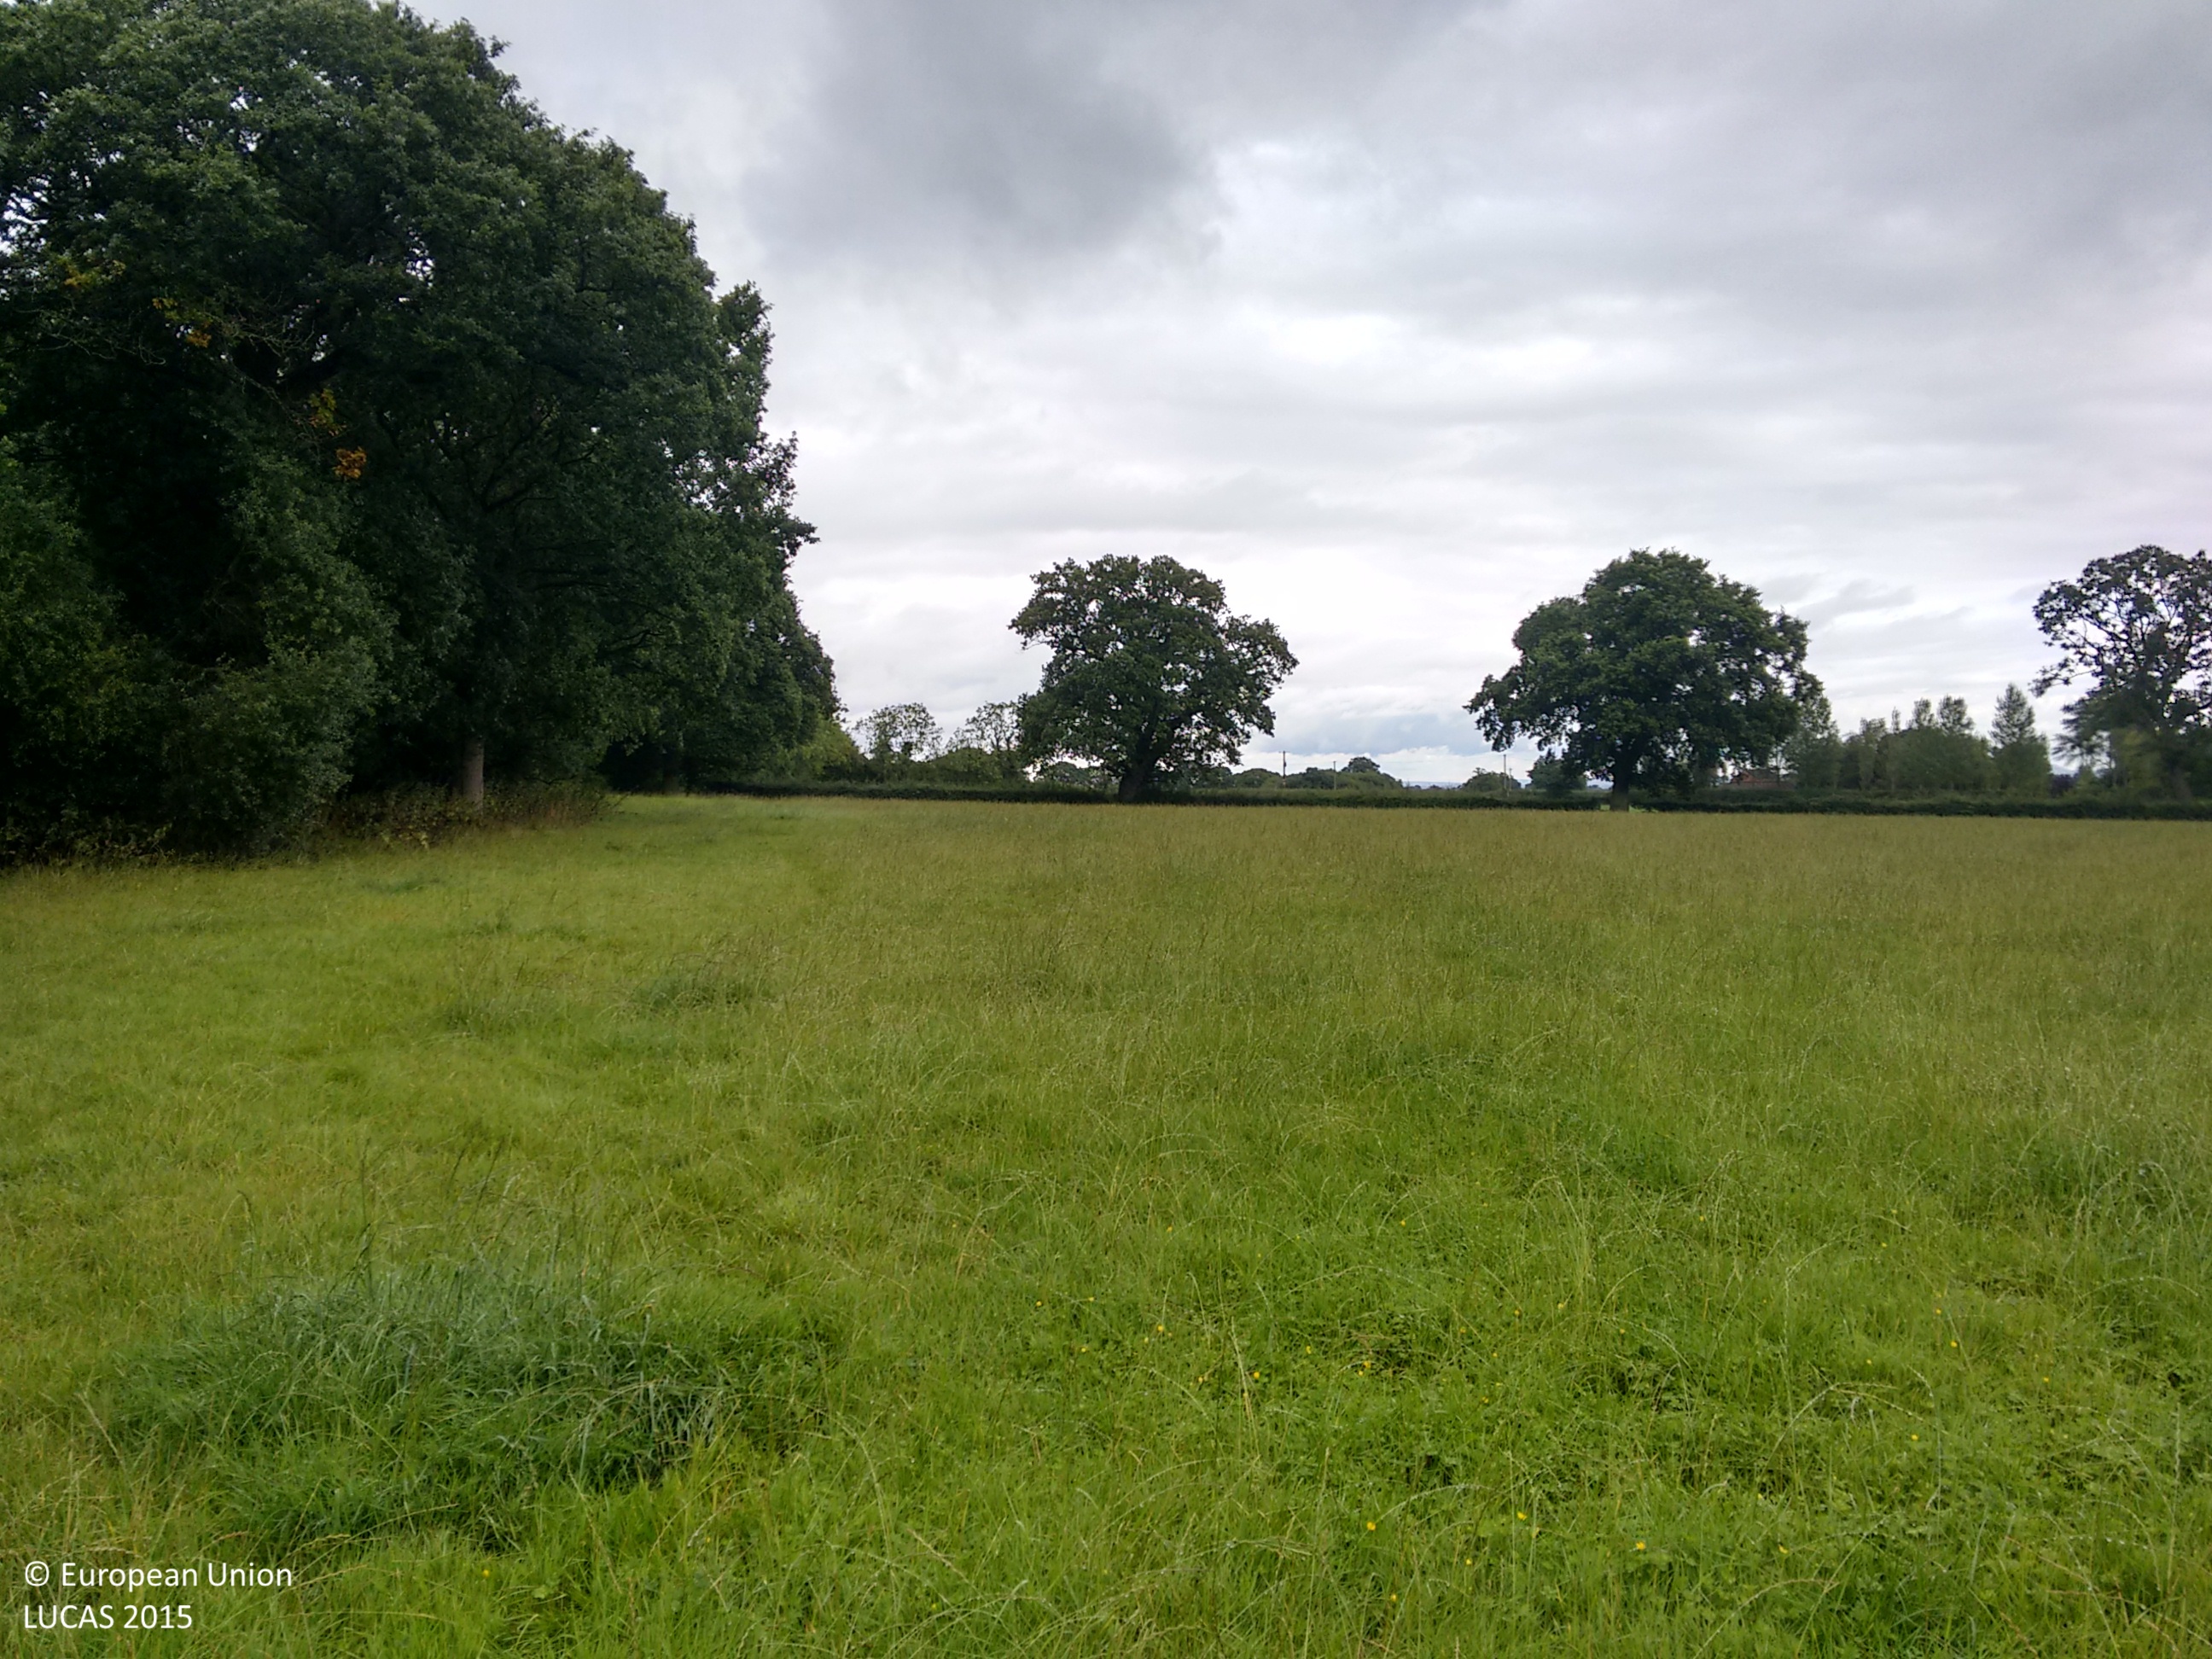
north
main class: Grassland
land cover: Grassland without tree/shrub cover
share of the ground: > 75 %
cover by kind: herbaceous plants 100 %
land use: Agriculture (excluding fallow land and kitchen gardens)
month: September
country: GB
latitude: 52.9434
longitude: -2.9156
